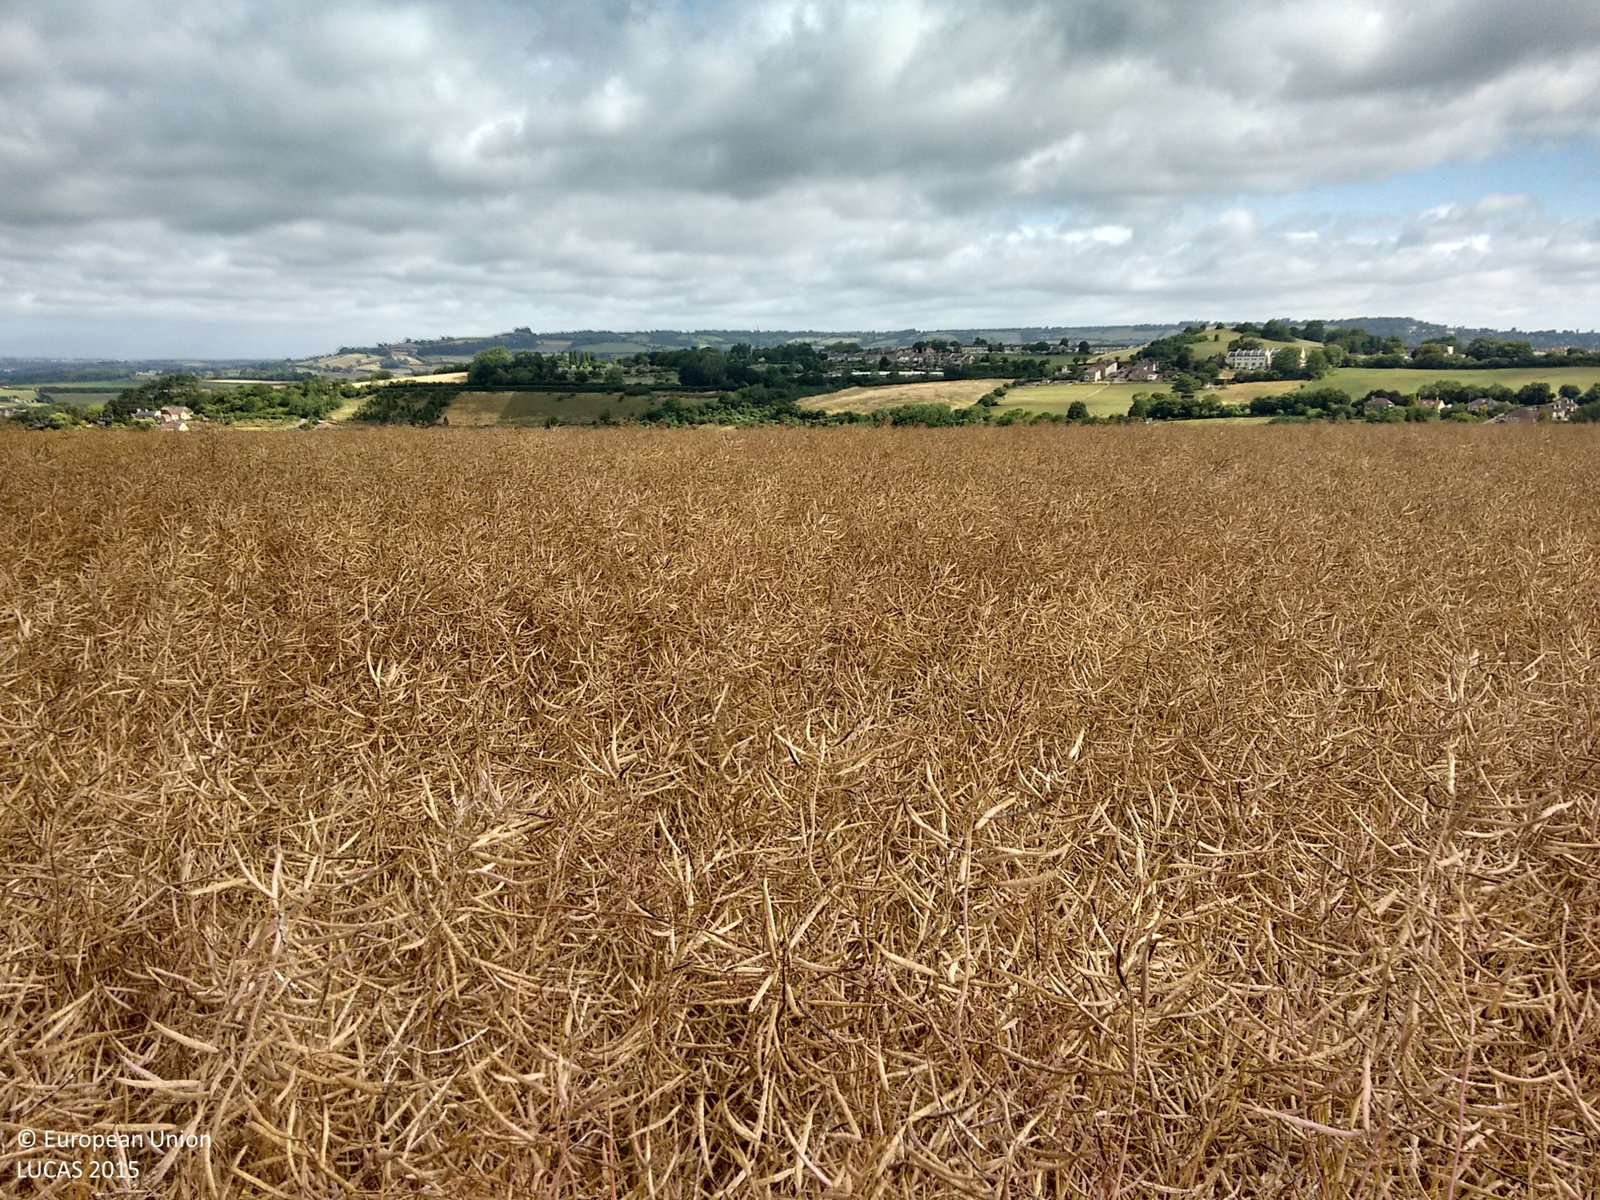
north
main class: Cropland
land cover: Rape and turnip rape
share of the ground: > 75 %
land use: Agriculture (excluding fallow land and kitchen gardens)
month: July
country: GB
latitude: 51.3601
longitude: -2.4013
